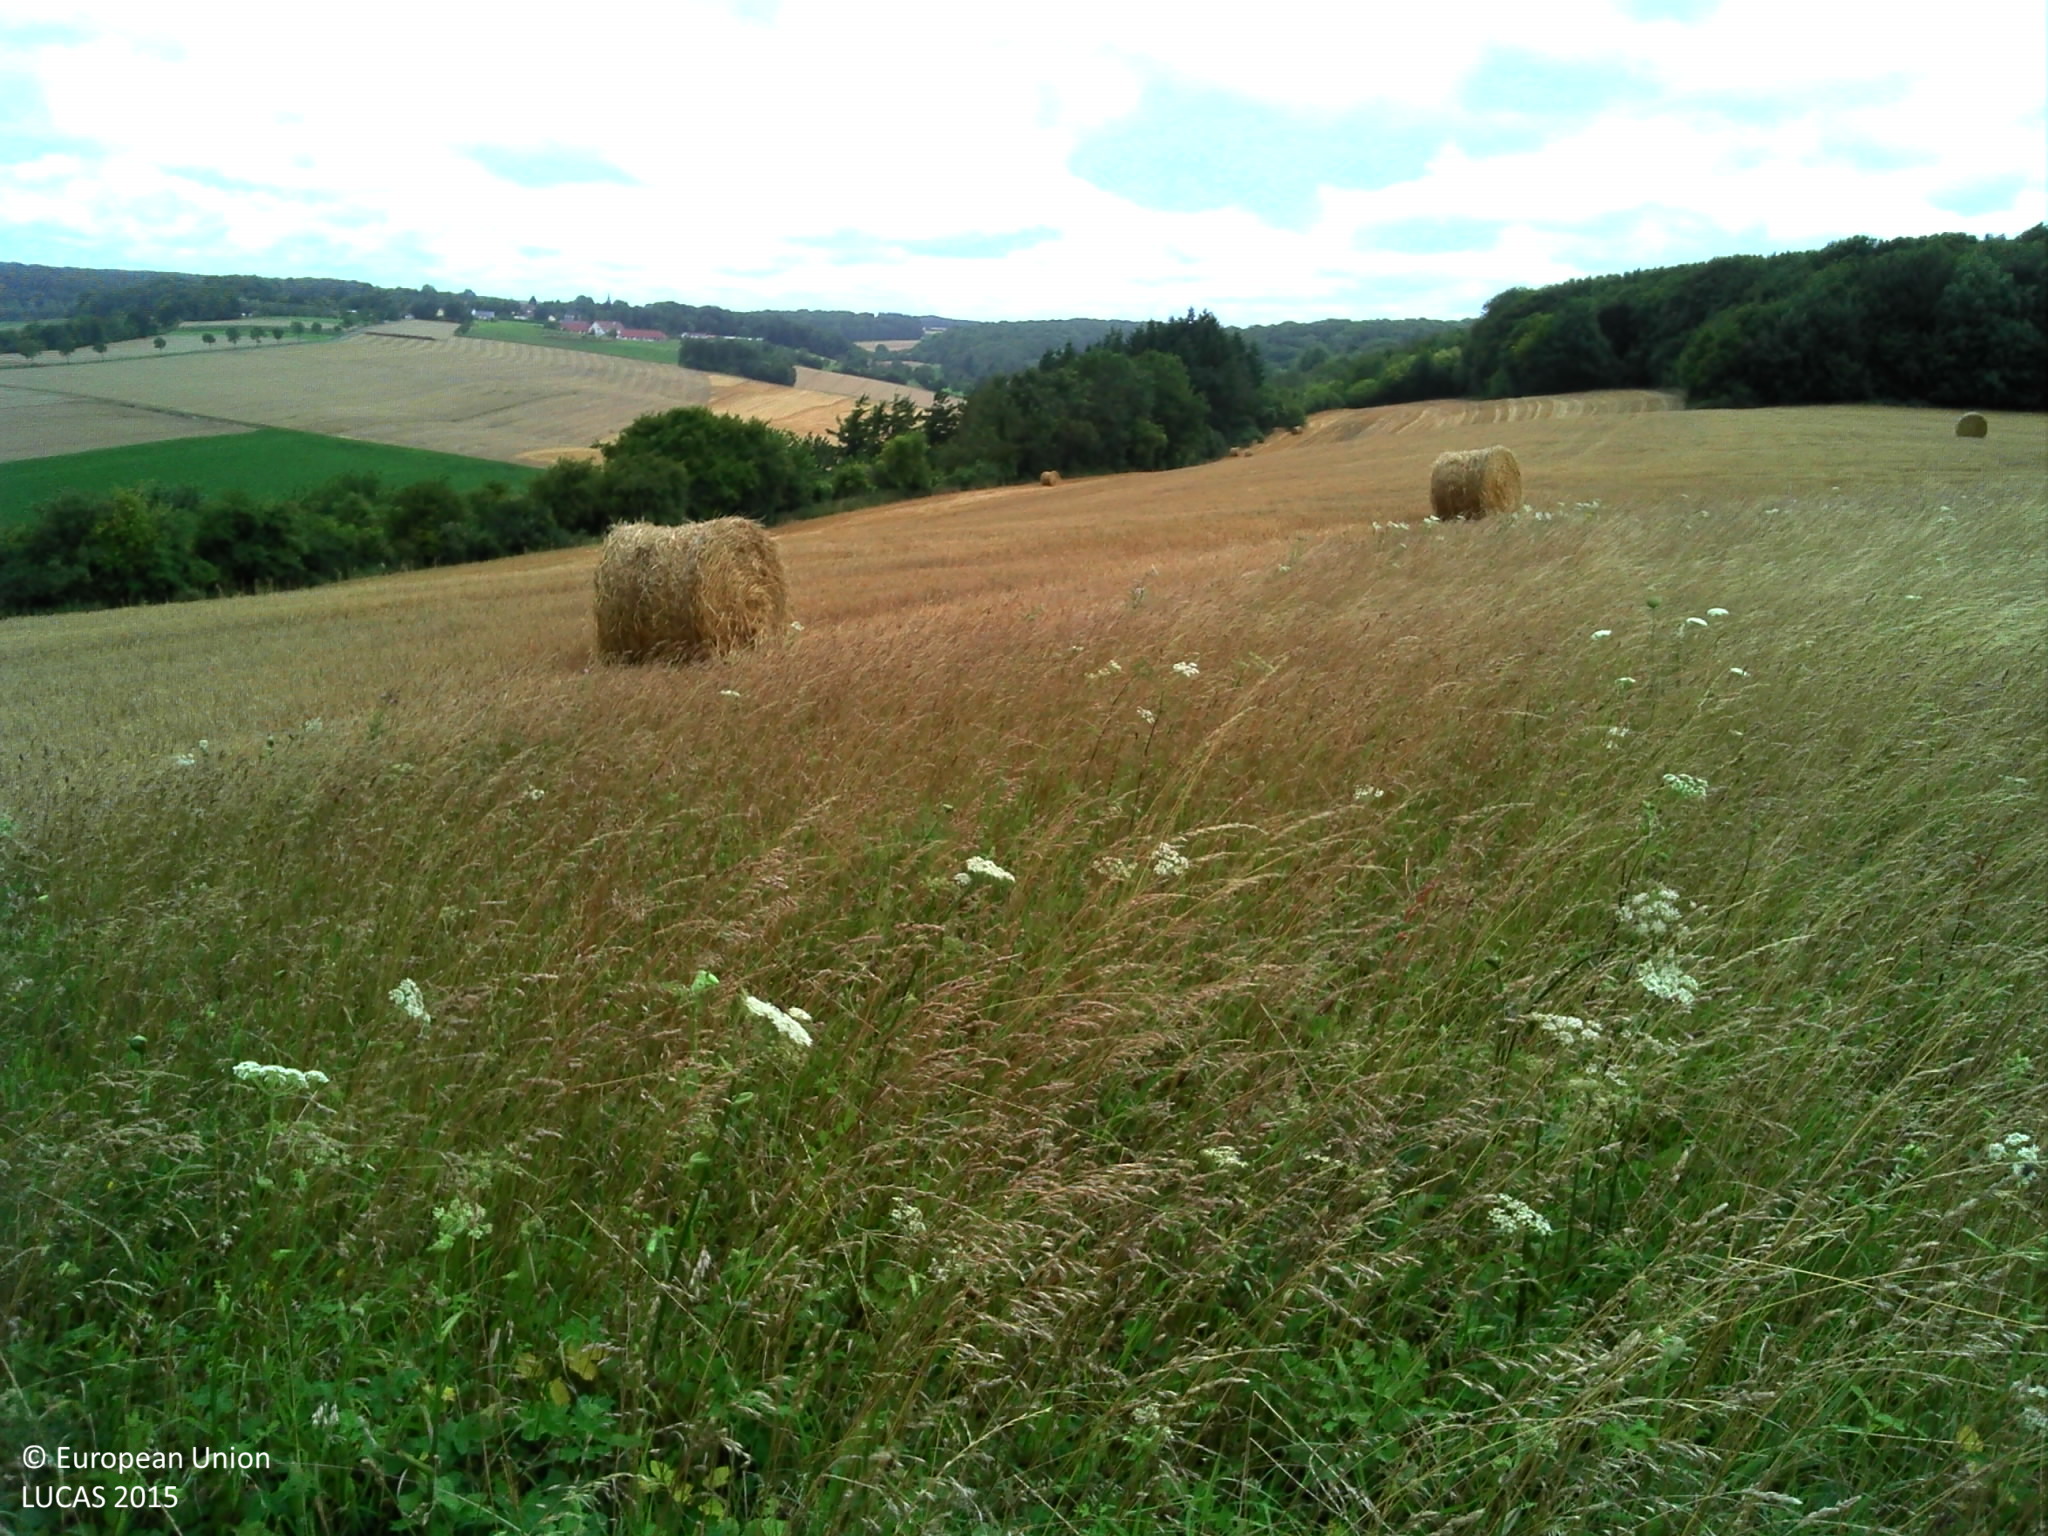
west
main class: Grassland
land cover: Grassland without tree/shrub cover
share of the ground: > 75 %
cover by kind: herbaceous plants 60 %
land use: Agriculture (excluding fallow land and kitchen gardens)
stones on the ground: 10 - 25 %
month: July
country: FR
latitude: 50.7385
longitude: 2.0636
